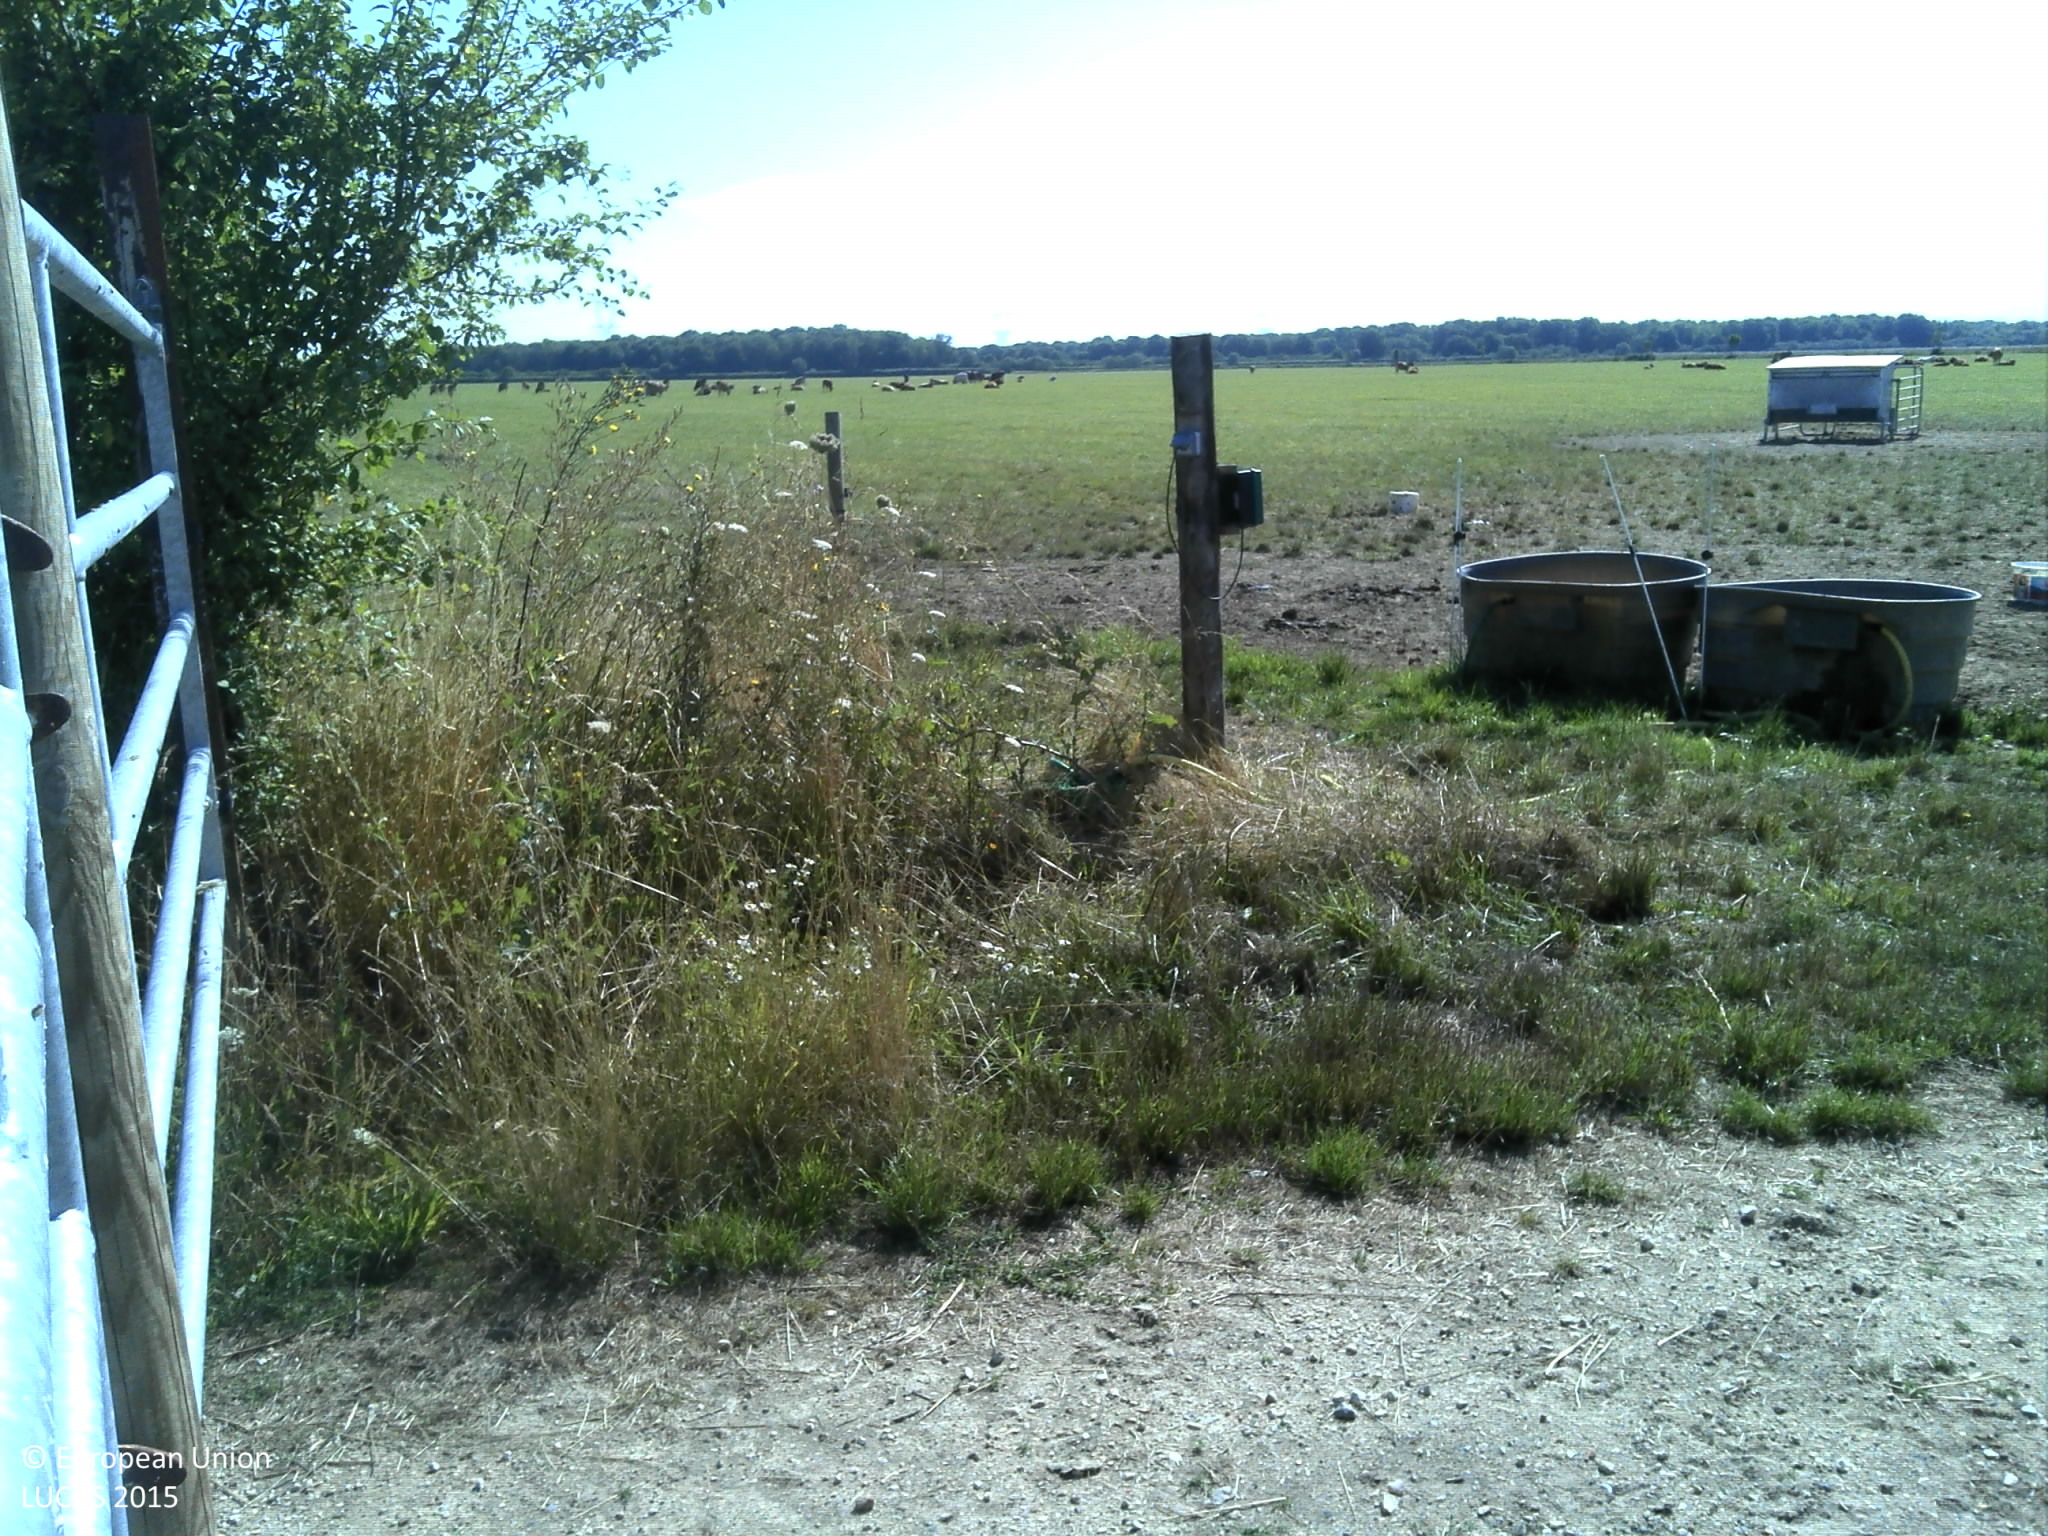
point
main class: Grassland
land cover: Grassland without tree/shrub cover
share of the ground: > 75 %
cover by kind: herbaceous plants 100 %
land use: Agriculture (excluding fallow land and kitchen gardens)
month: August
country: FR
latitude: 48.6670
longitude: 1.9064
